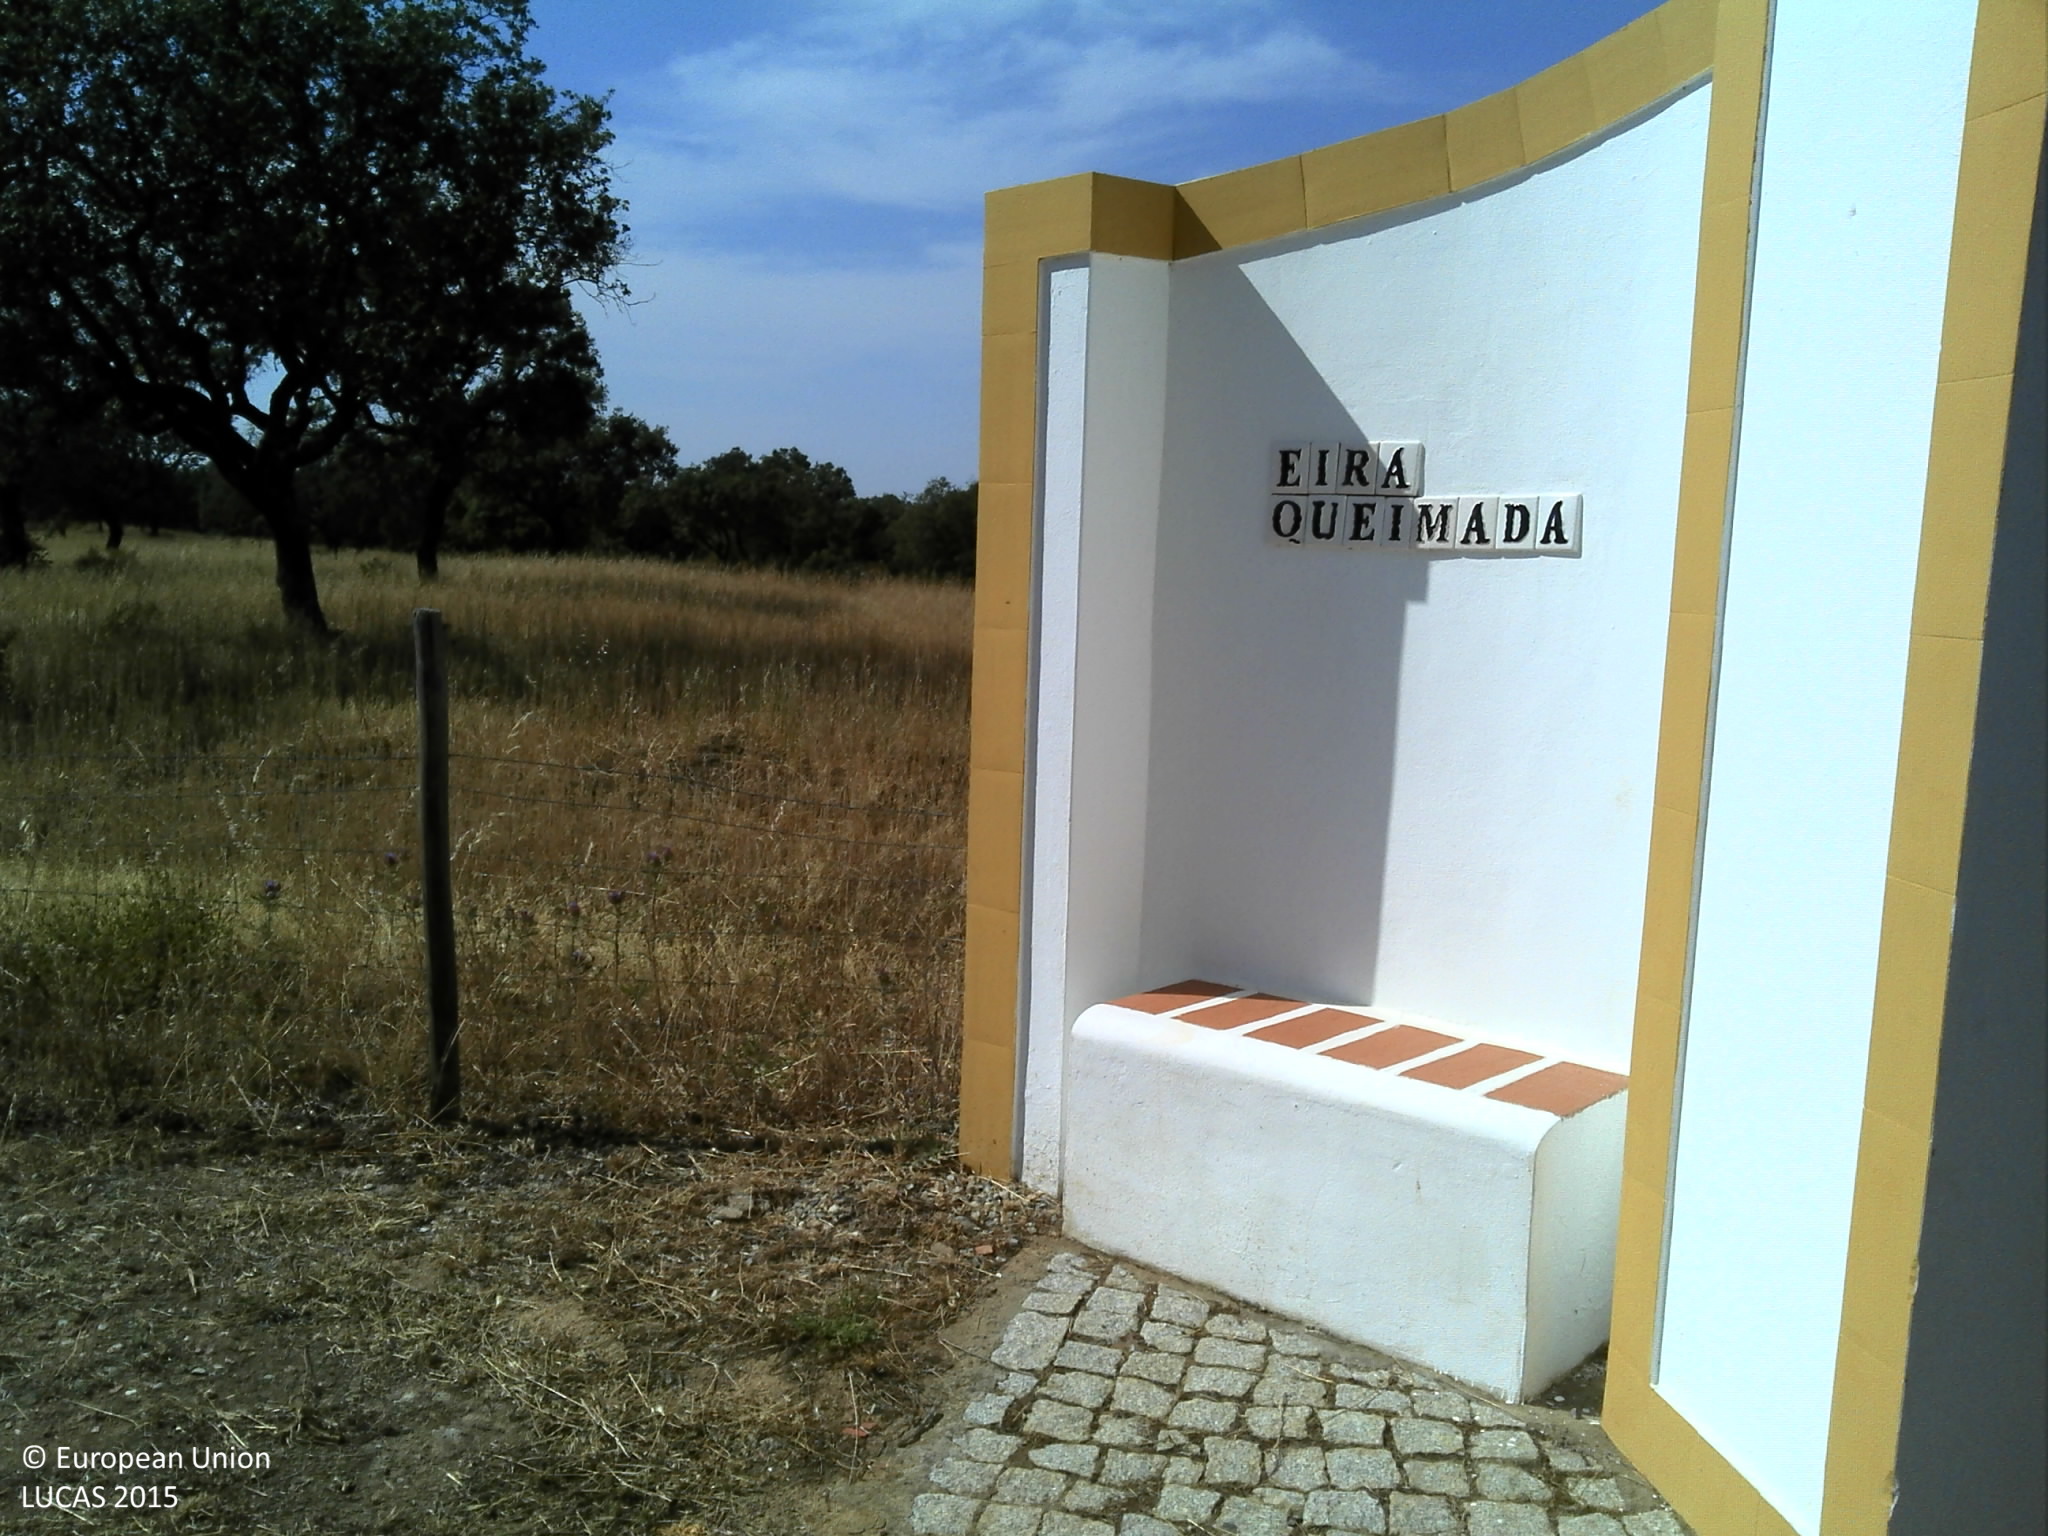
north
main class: Shrubland
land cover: Shrubland with sparse tree cover
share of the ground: > 75 %
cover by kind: shrubs 95 %, broadleaved forest trees 5 %
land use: Abandoned areas
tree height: > 5 m
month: June
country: PT
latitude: 37.6895
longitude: -7.4649
